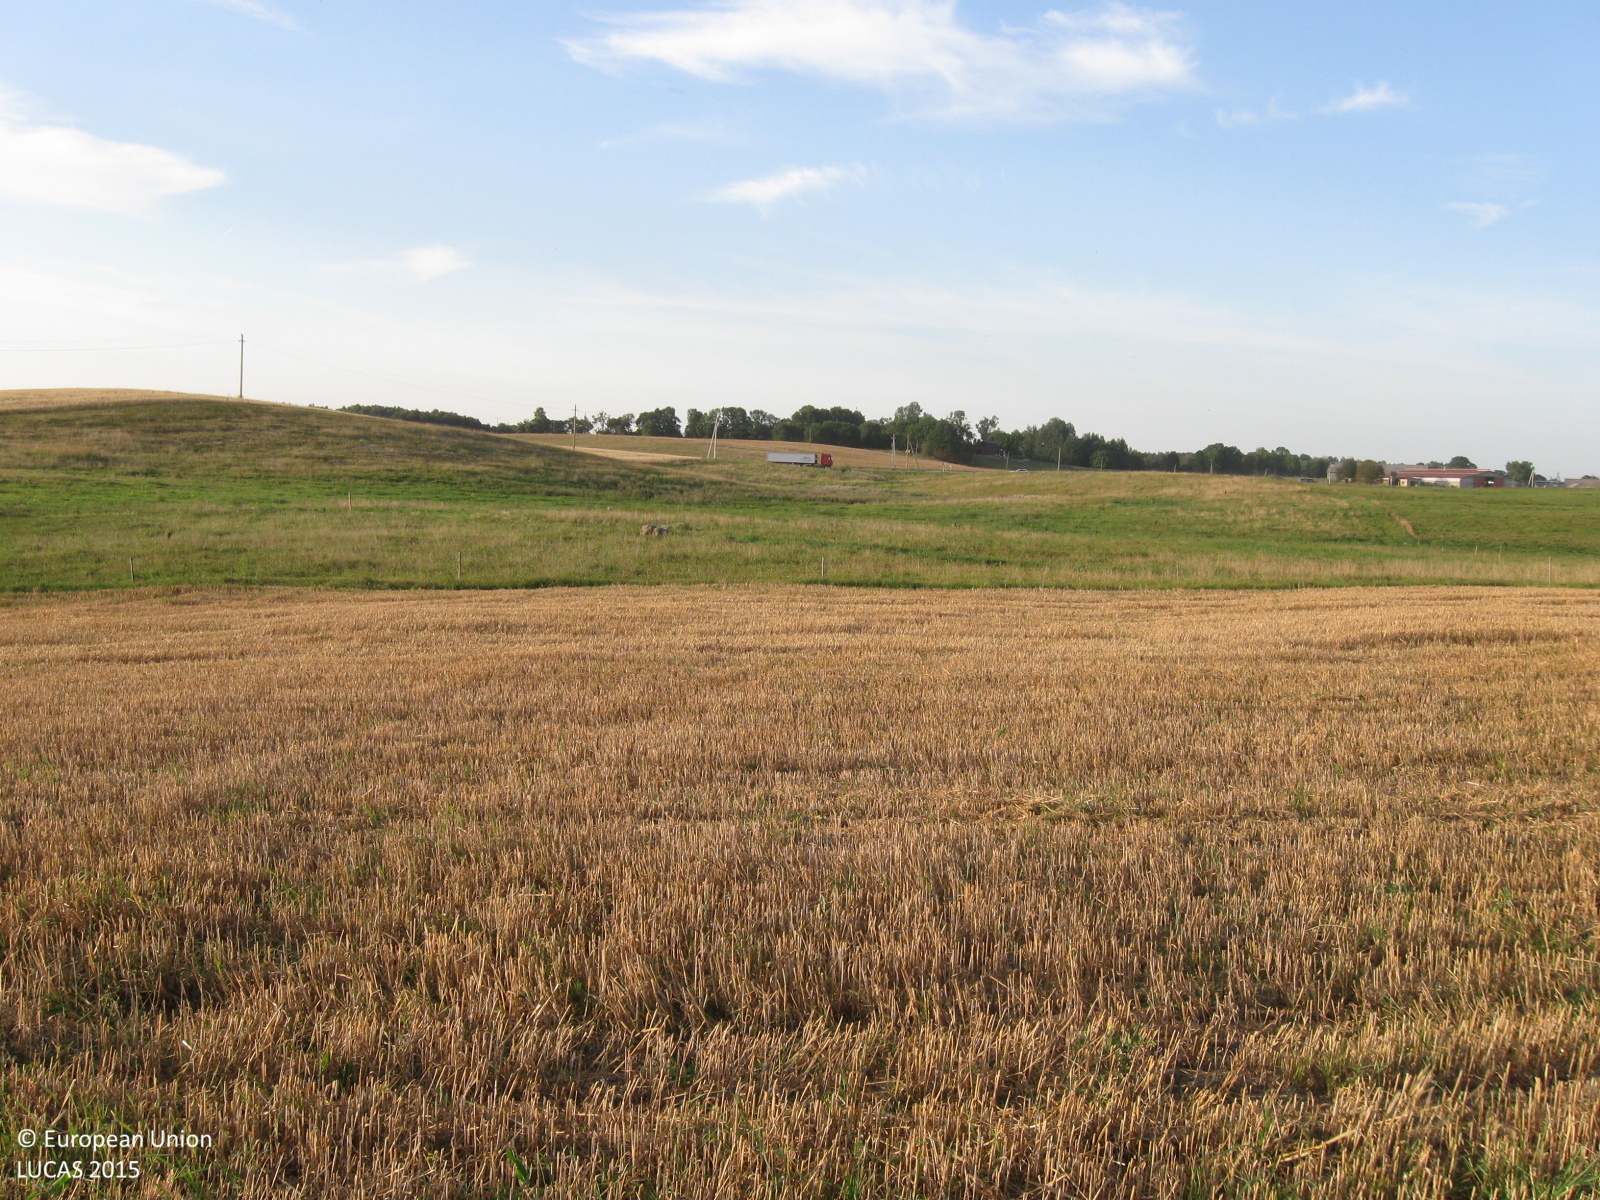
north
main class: Cropland
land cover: Barley
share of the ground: > 75 %
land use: Agriculture (excluding fallow land and kitchen gardens)
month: August
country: LT
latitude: 55.4685
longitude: 22.6388
